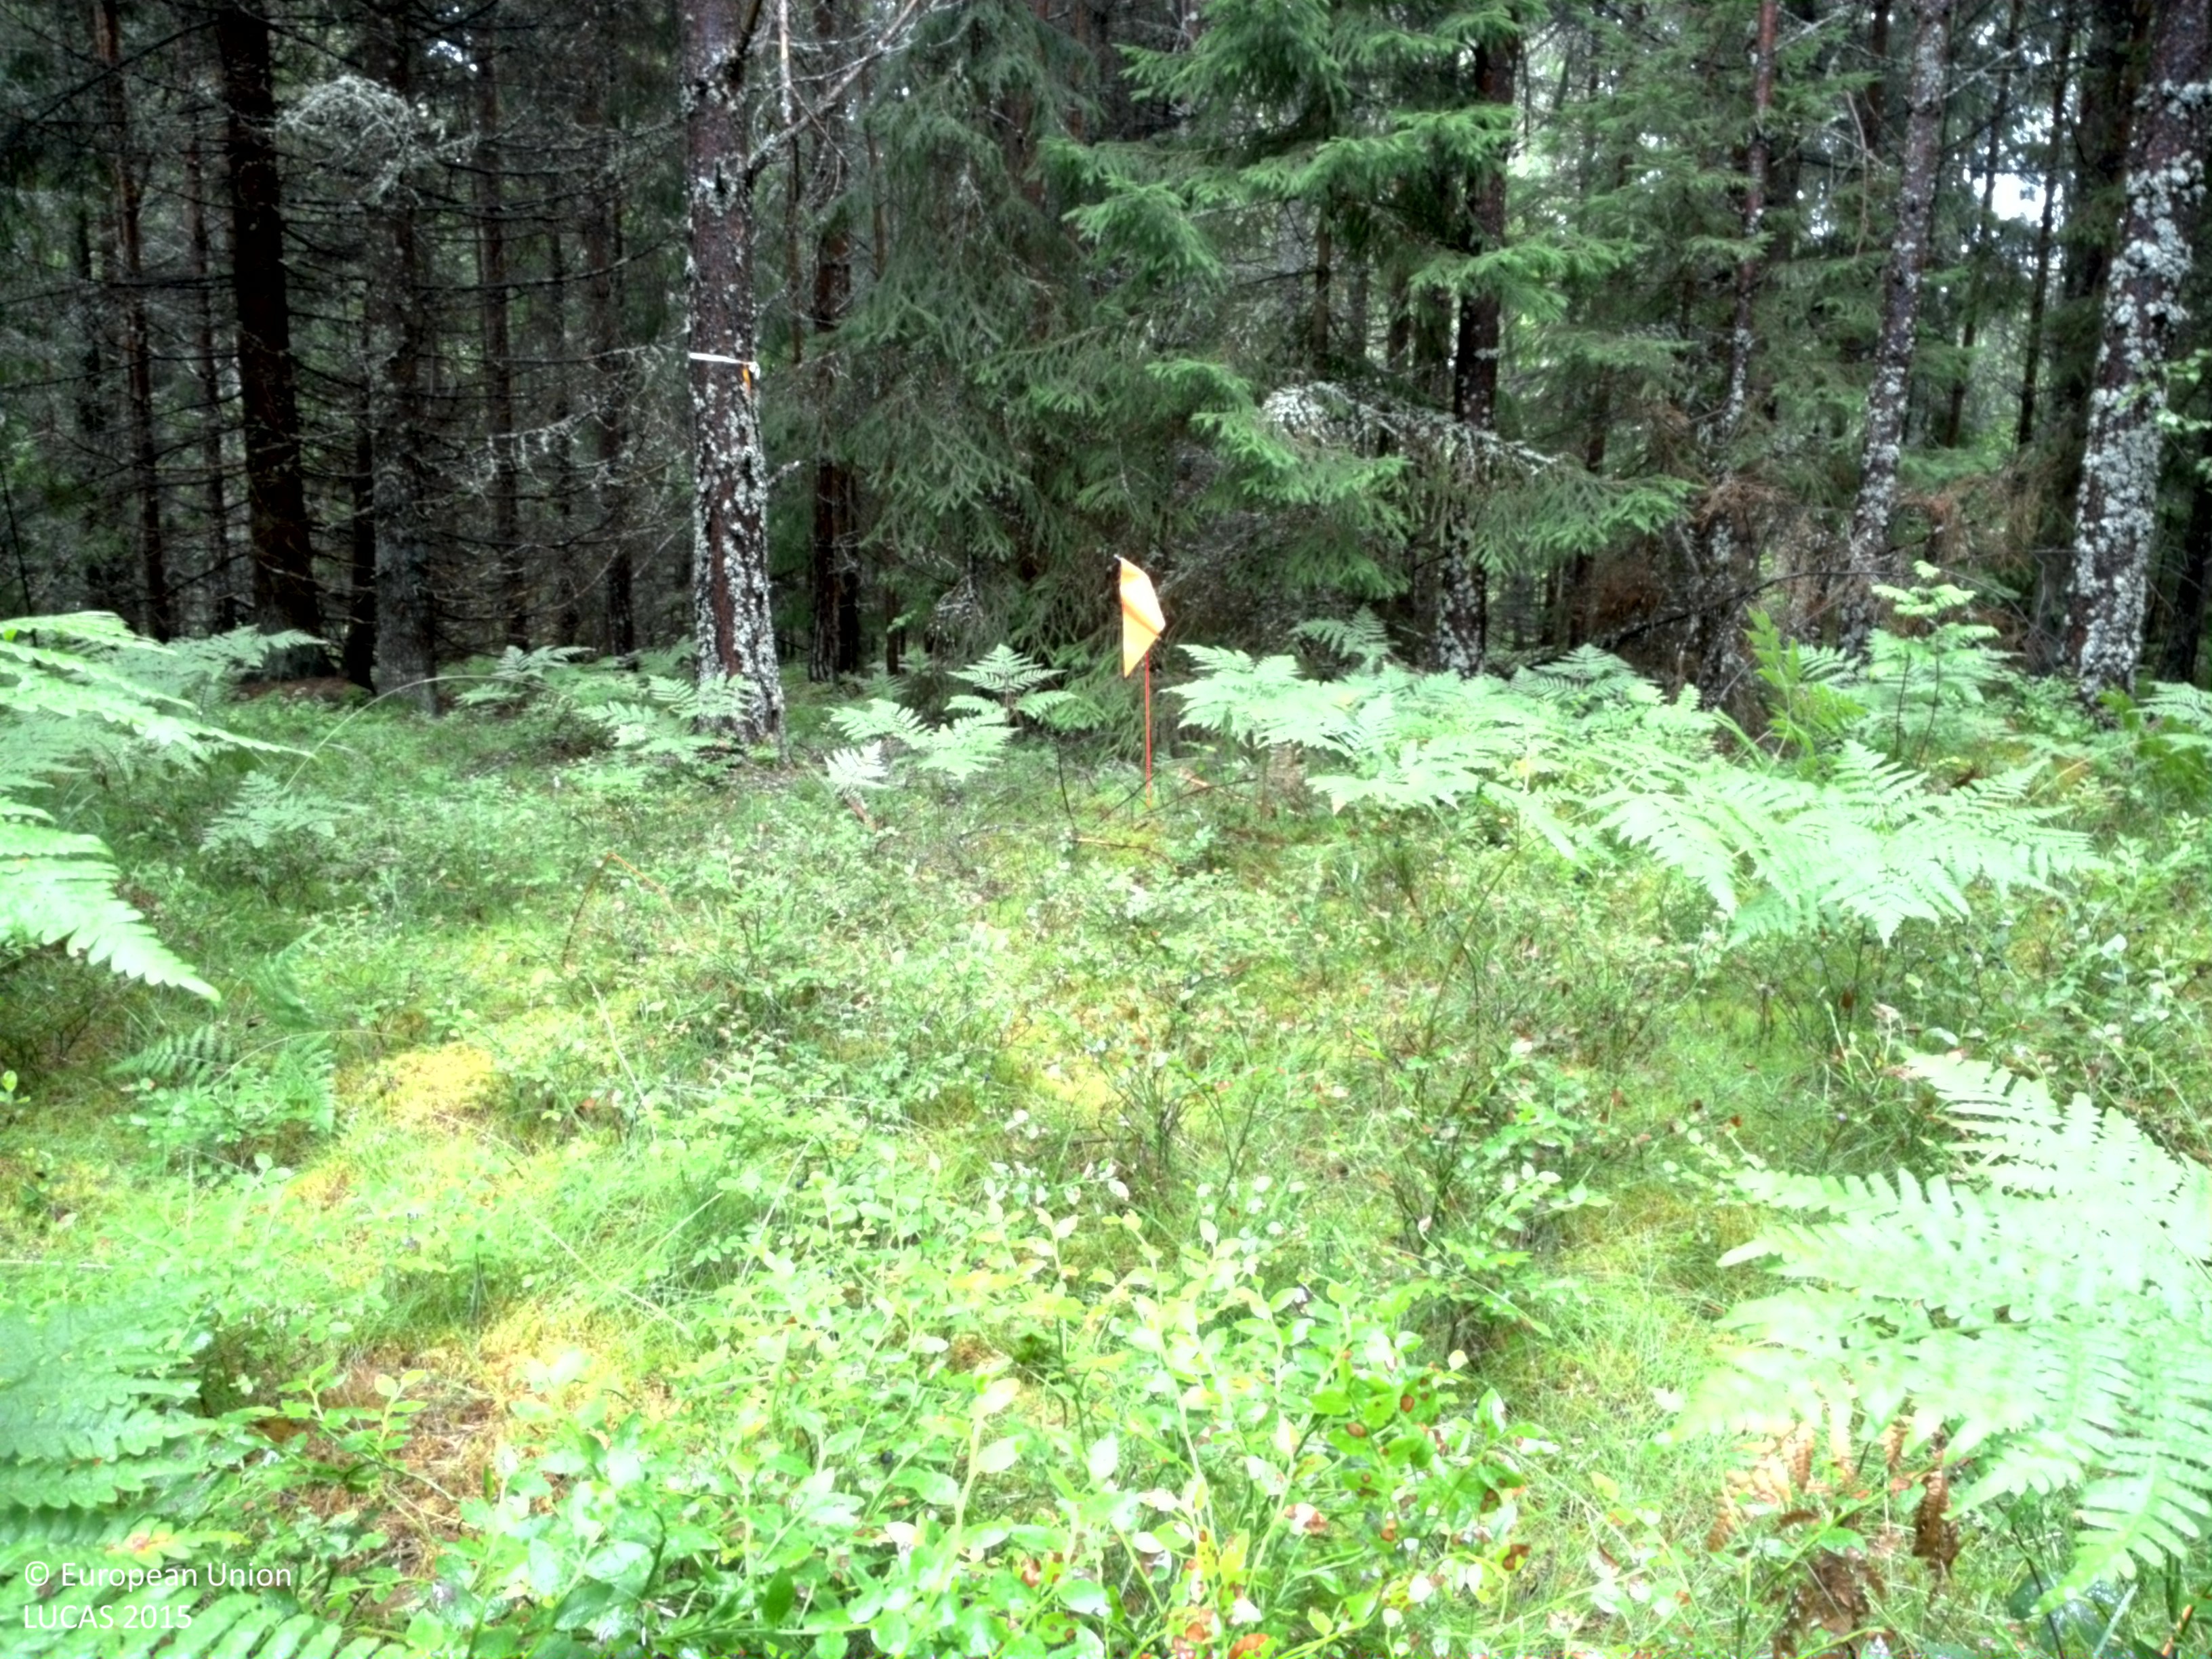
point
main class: Woodland
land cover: Spruce dominated coniferous woodland
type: boreal forest
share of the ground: 50 - 75 %
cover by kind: coniferous forest trees 60 %, lichens and mosses 35 %, broadleaved forest trees 5 %
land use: Forestry
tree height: > 5 m
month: July
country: SE
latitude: 59.6748
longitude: 18.7188
